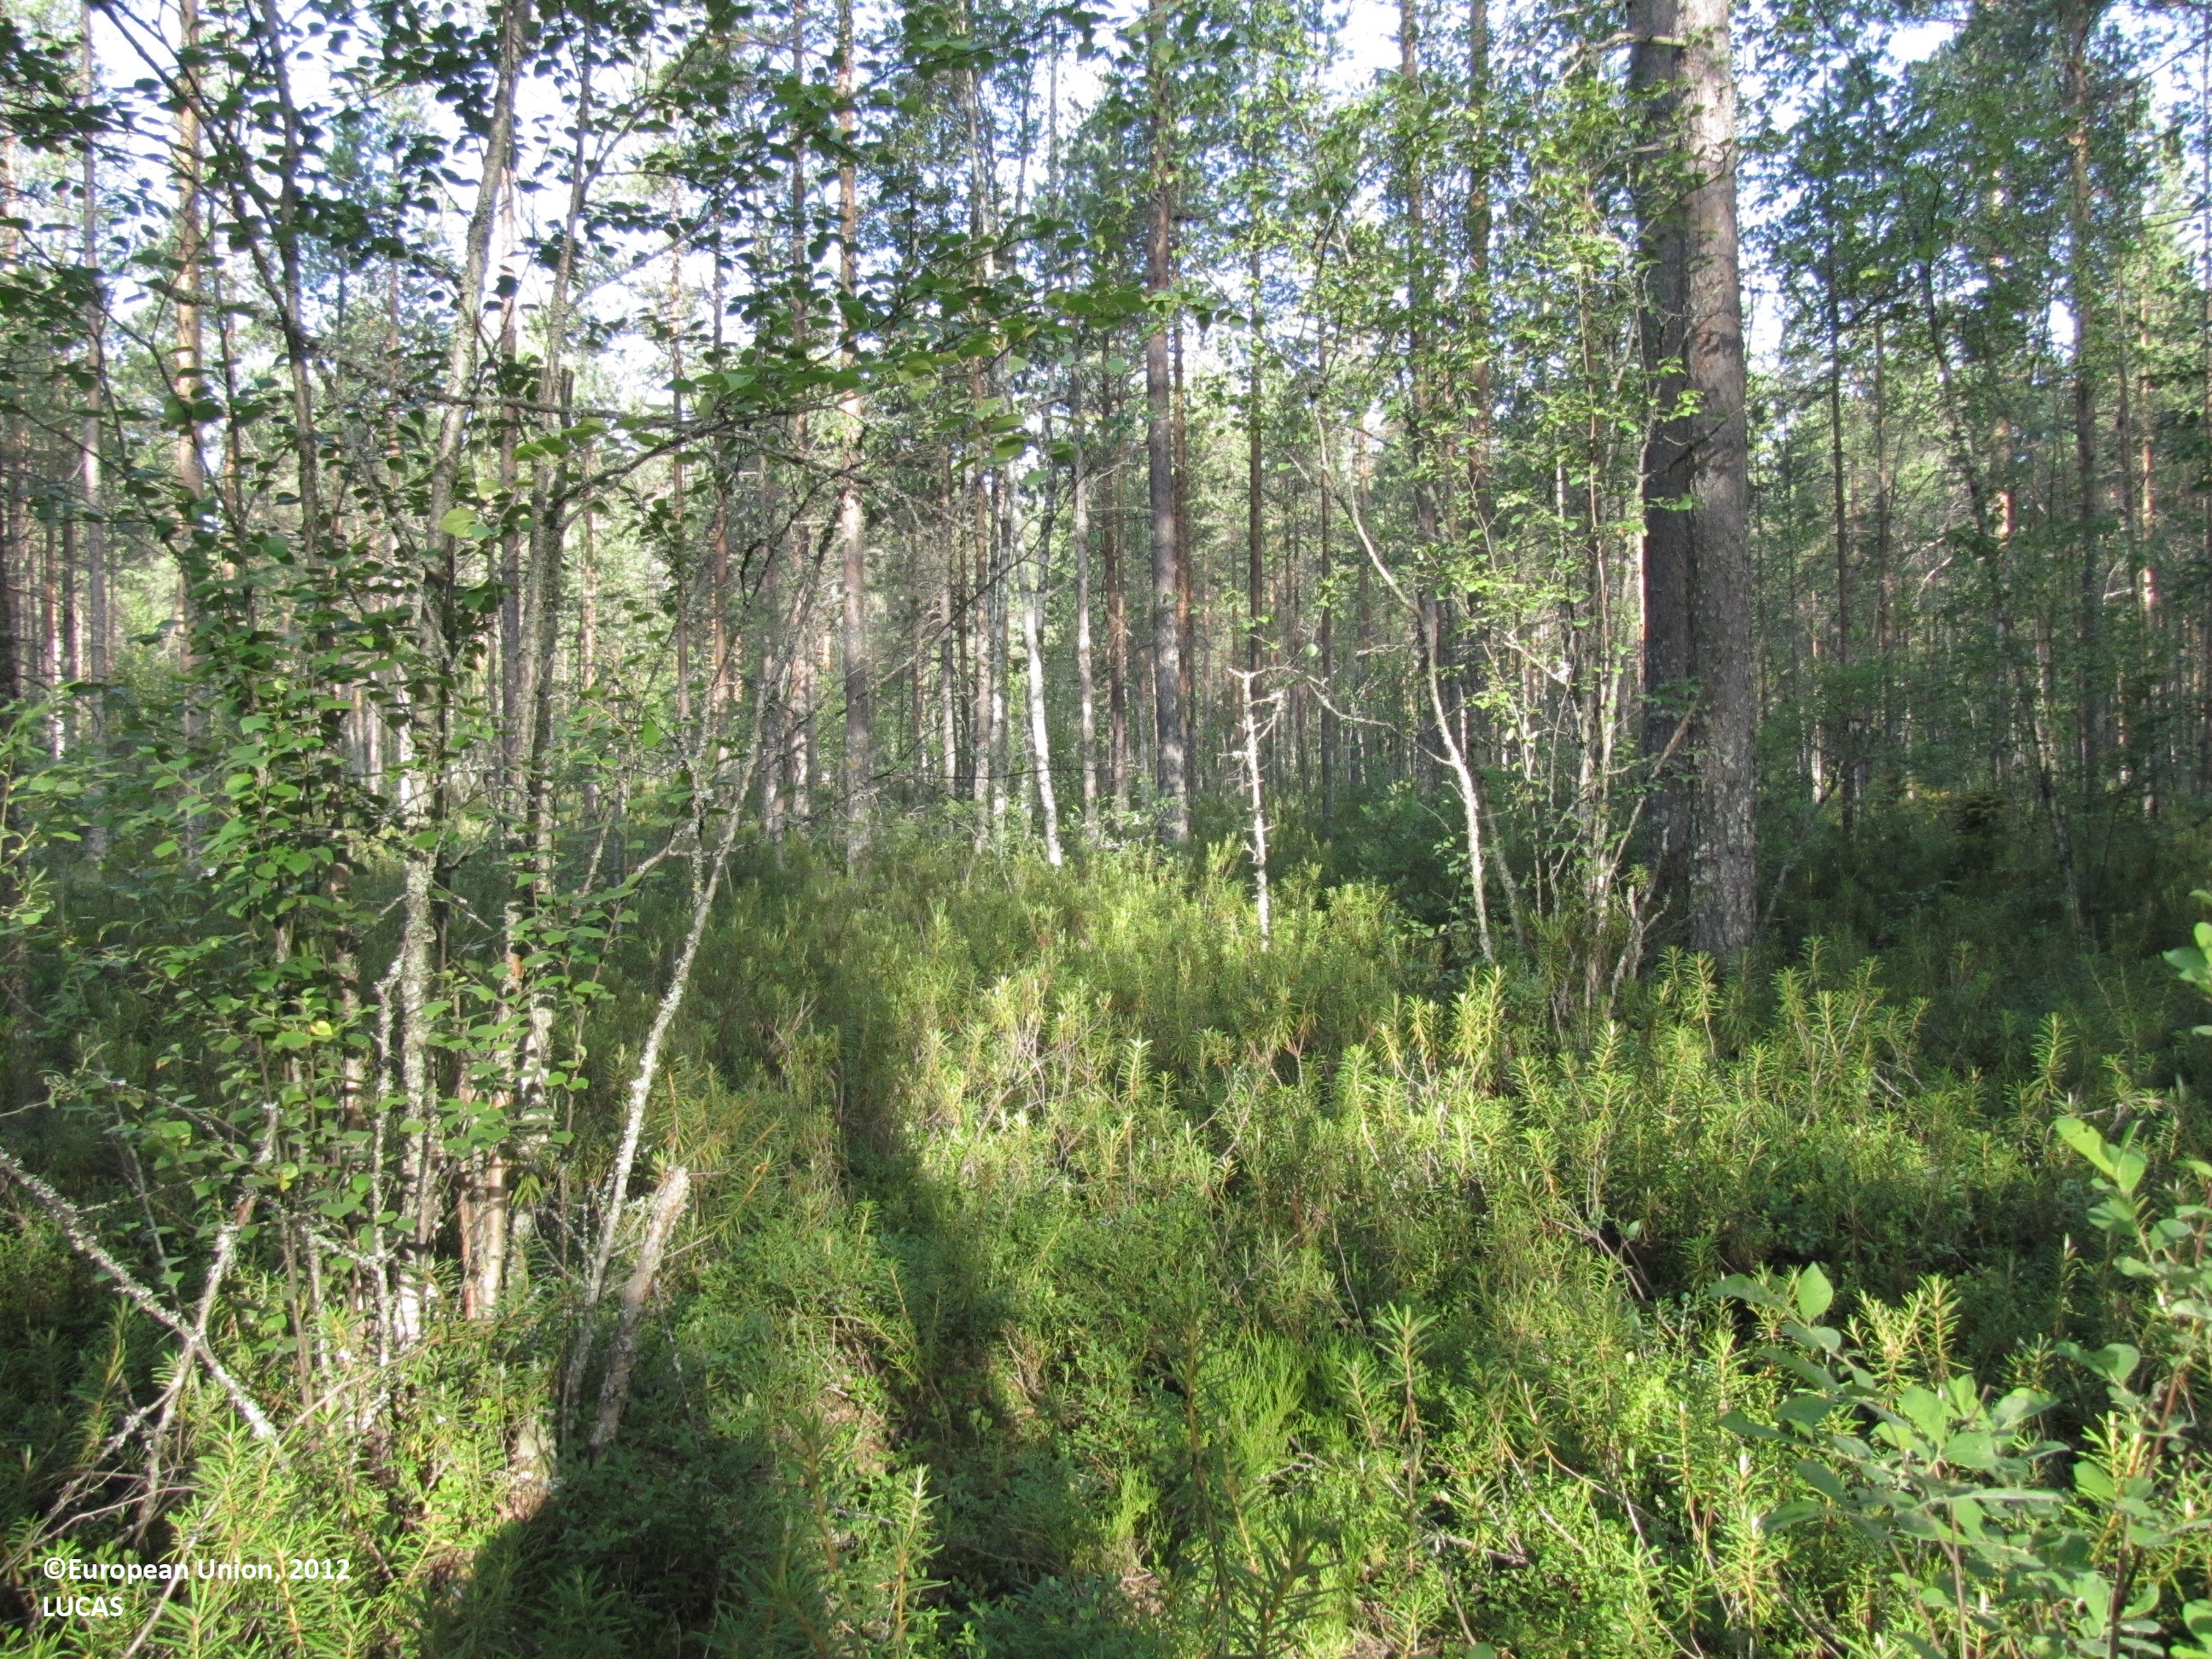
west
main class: Woodland
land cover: Pine dominated coniferous woodland
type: mire and swamp forests
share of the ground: > 75 %
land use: Forestry
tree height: > 5 m
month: July
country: FI
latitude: 62.6062
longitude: 23.2949
